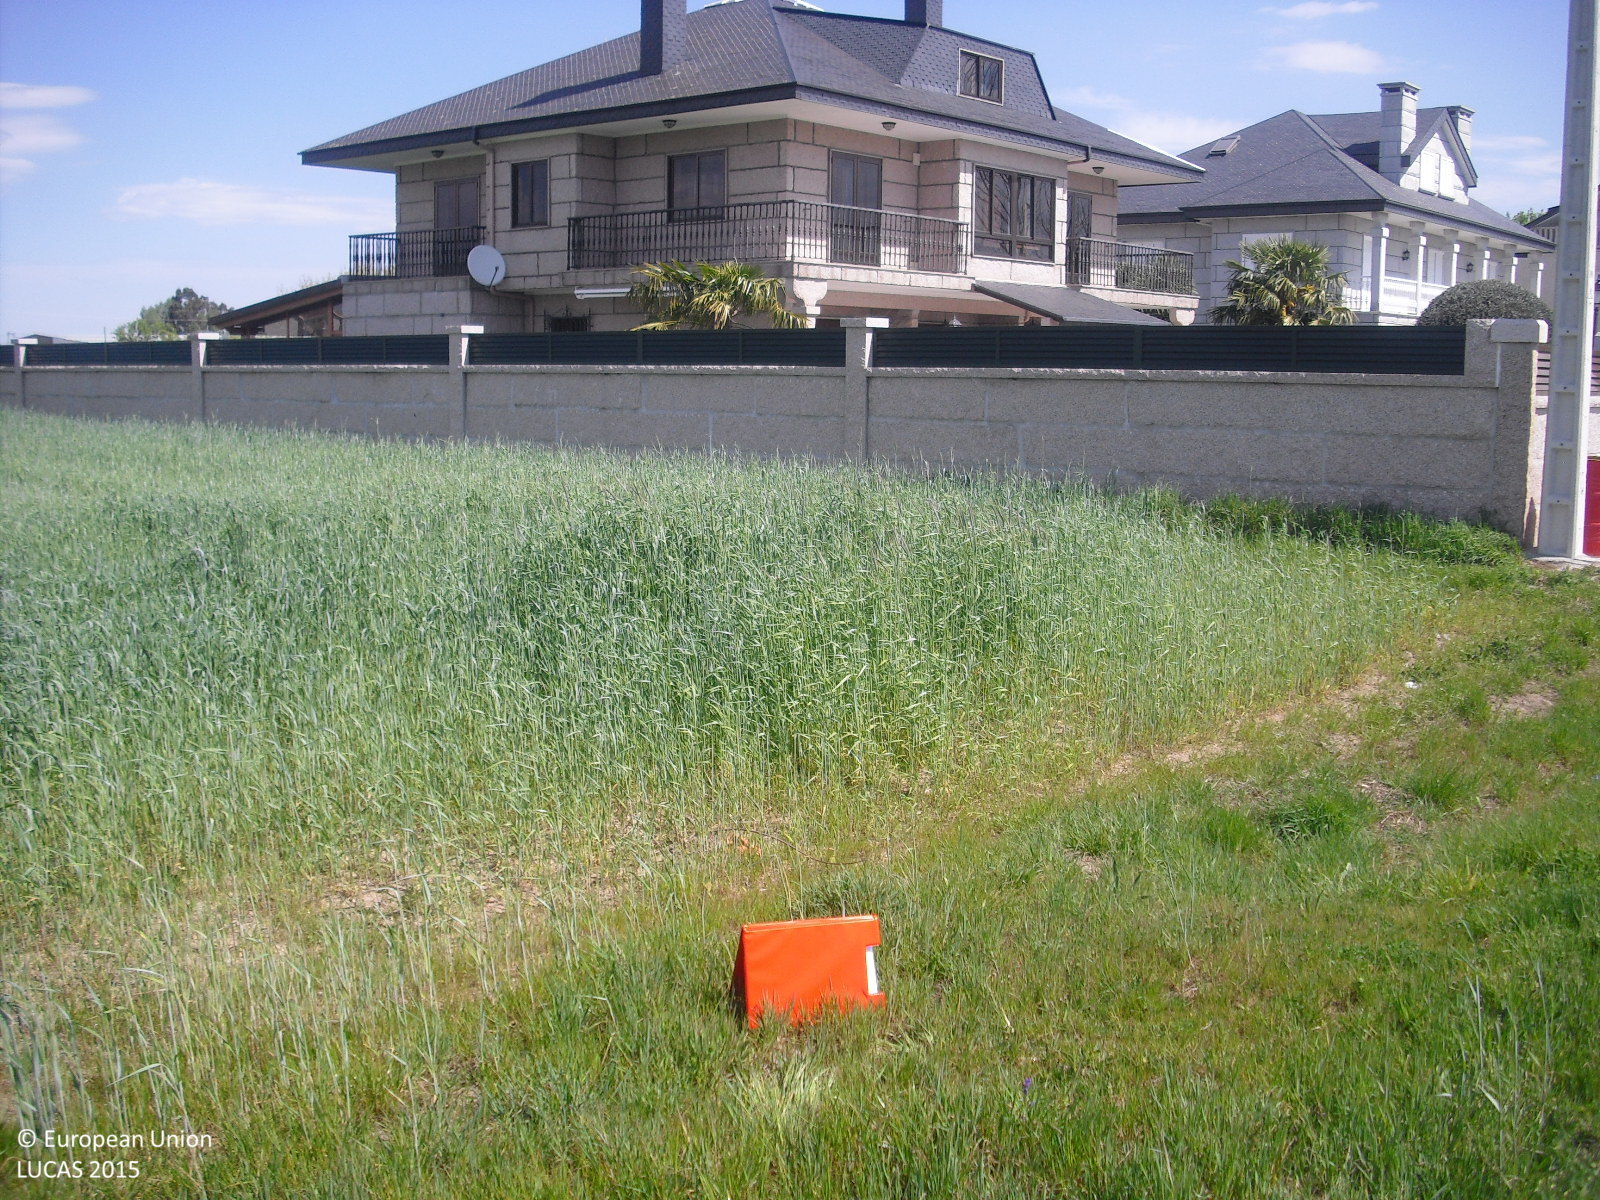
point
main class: Cropland
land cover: Rye
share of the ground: > 75 %
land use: Agriculture (excluding fallow land and kitchen gardens)
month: April
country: ES
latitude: 42.0715
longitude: -7.7277
